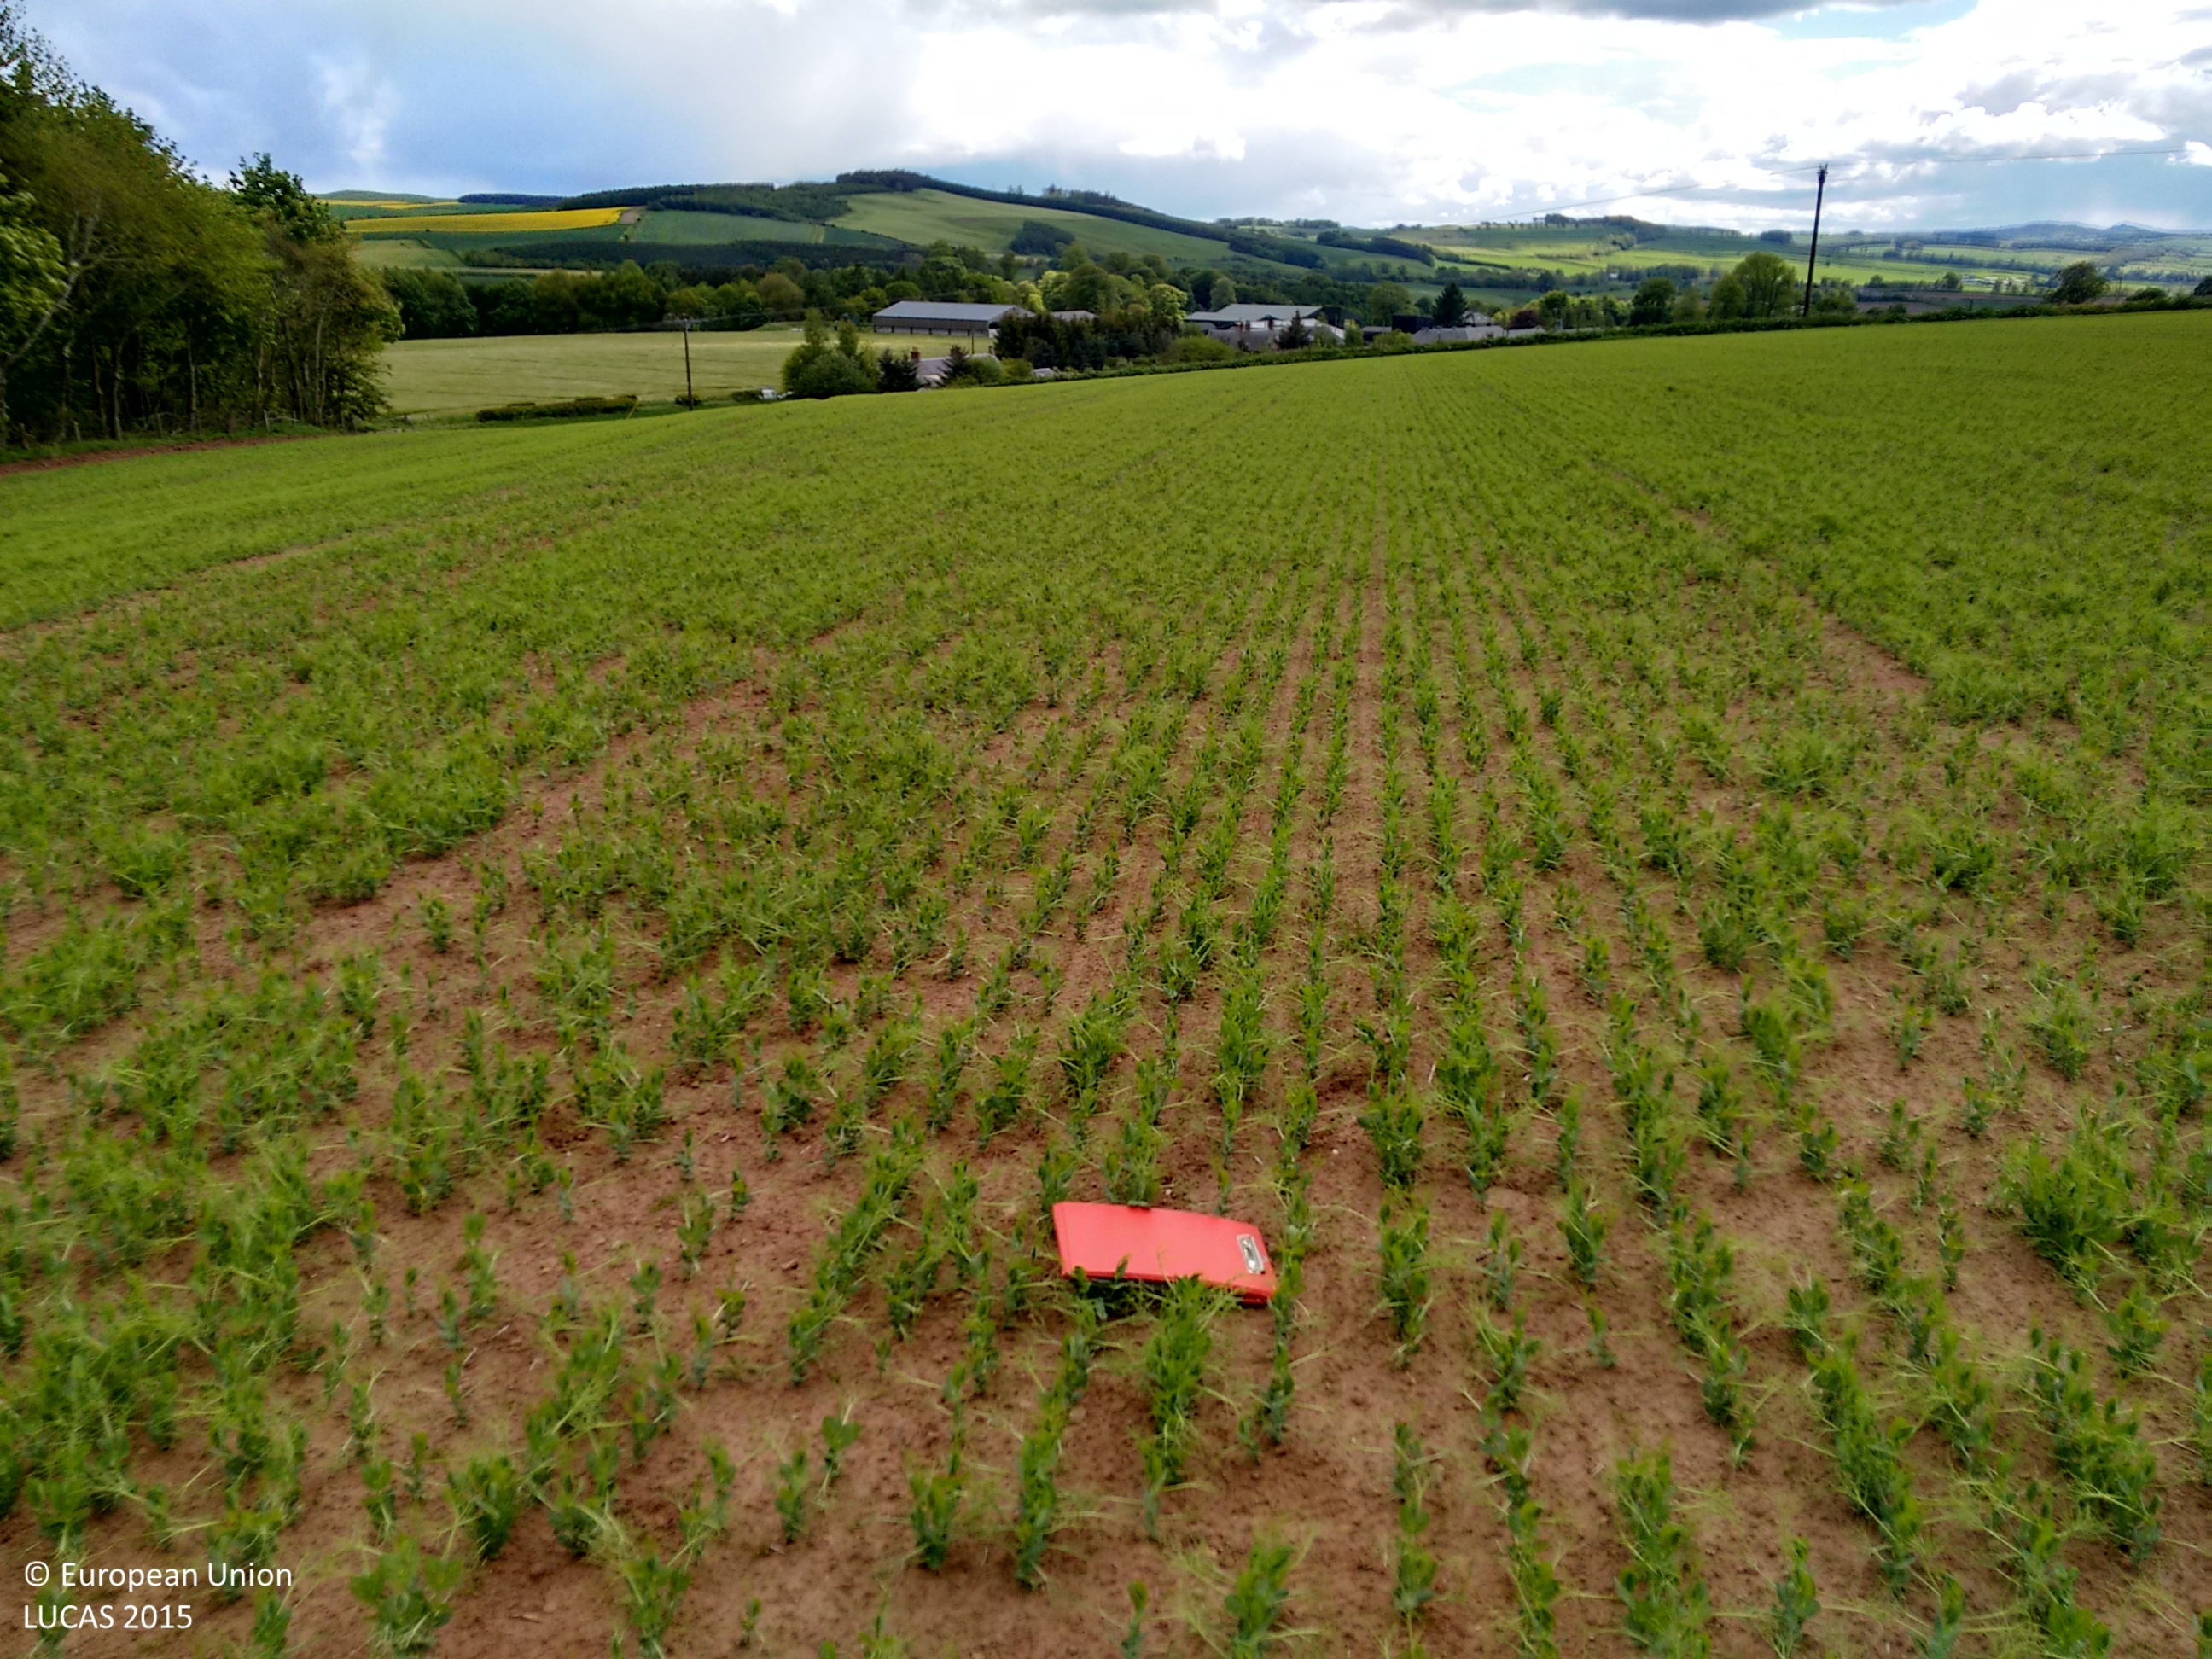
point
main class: Cropland
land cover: Dry pulses
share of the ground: 25 - 50 %
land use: Agriculture (excluding fallow land and kitchen gardens)
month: May
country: GB
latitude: 55.5433
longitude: -2.4372
